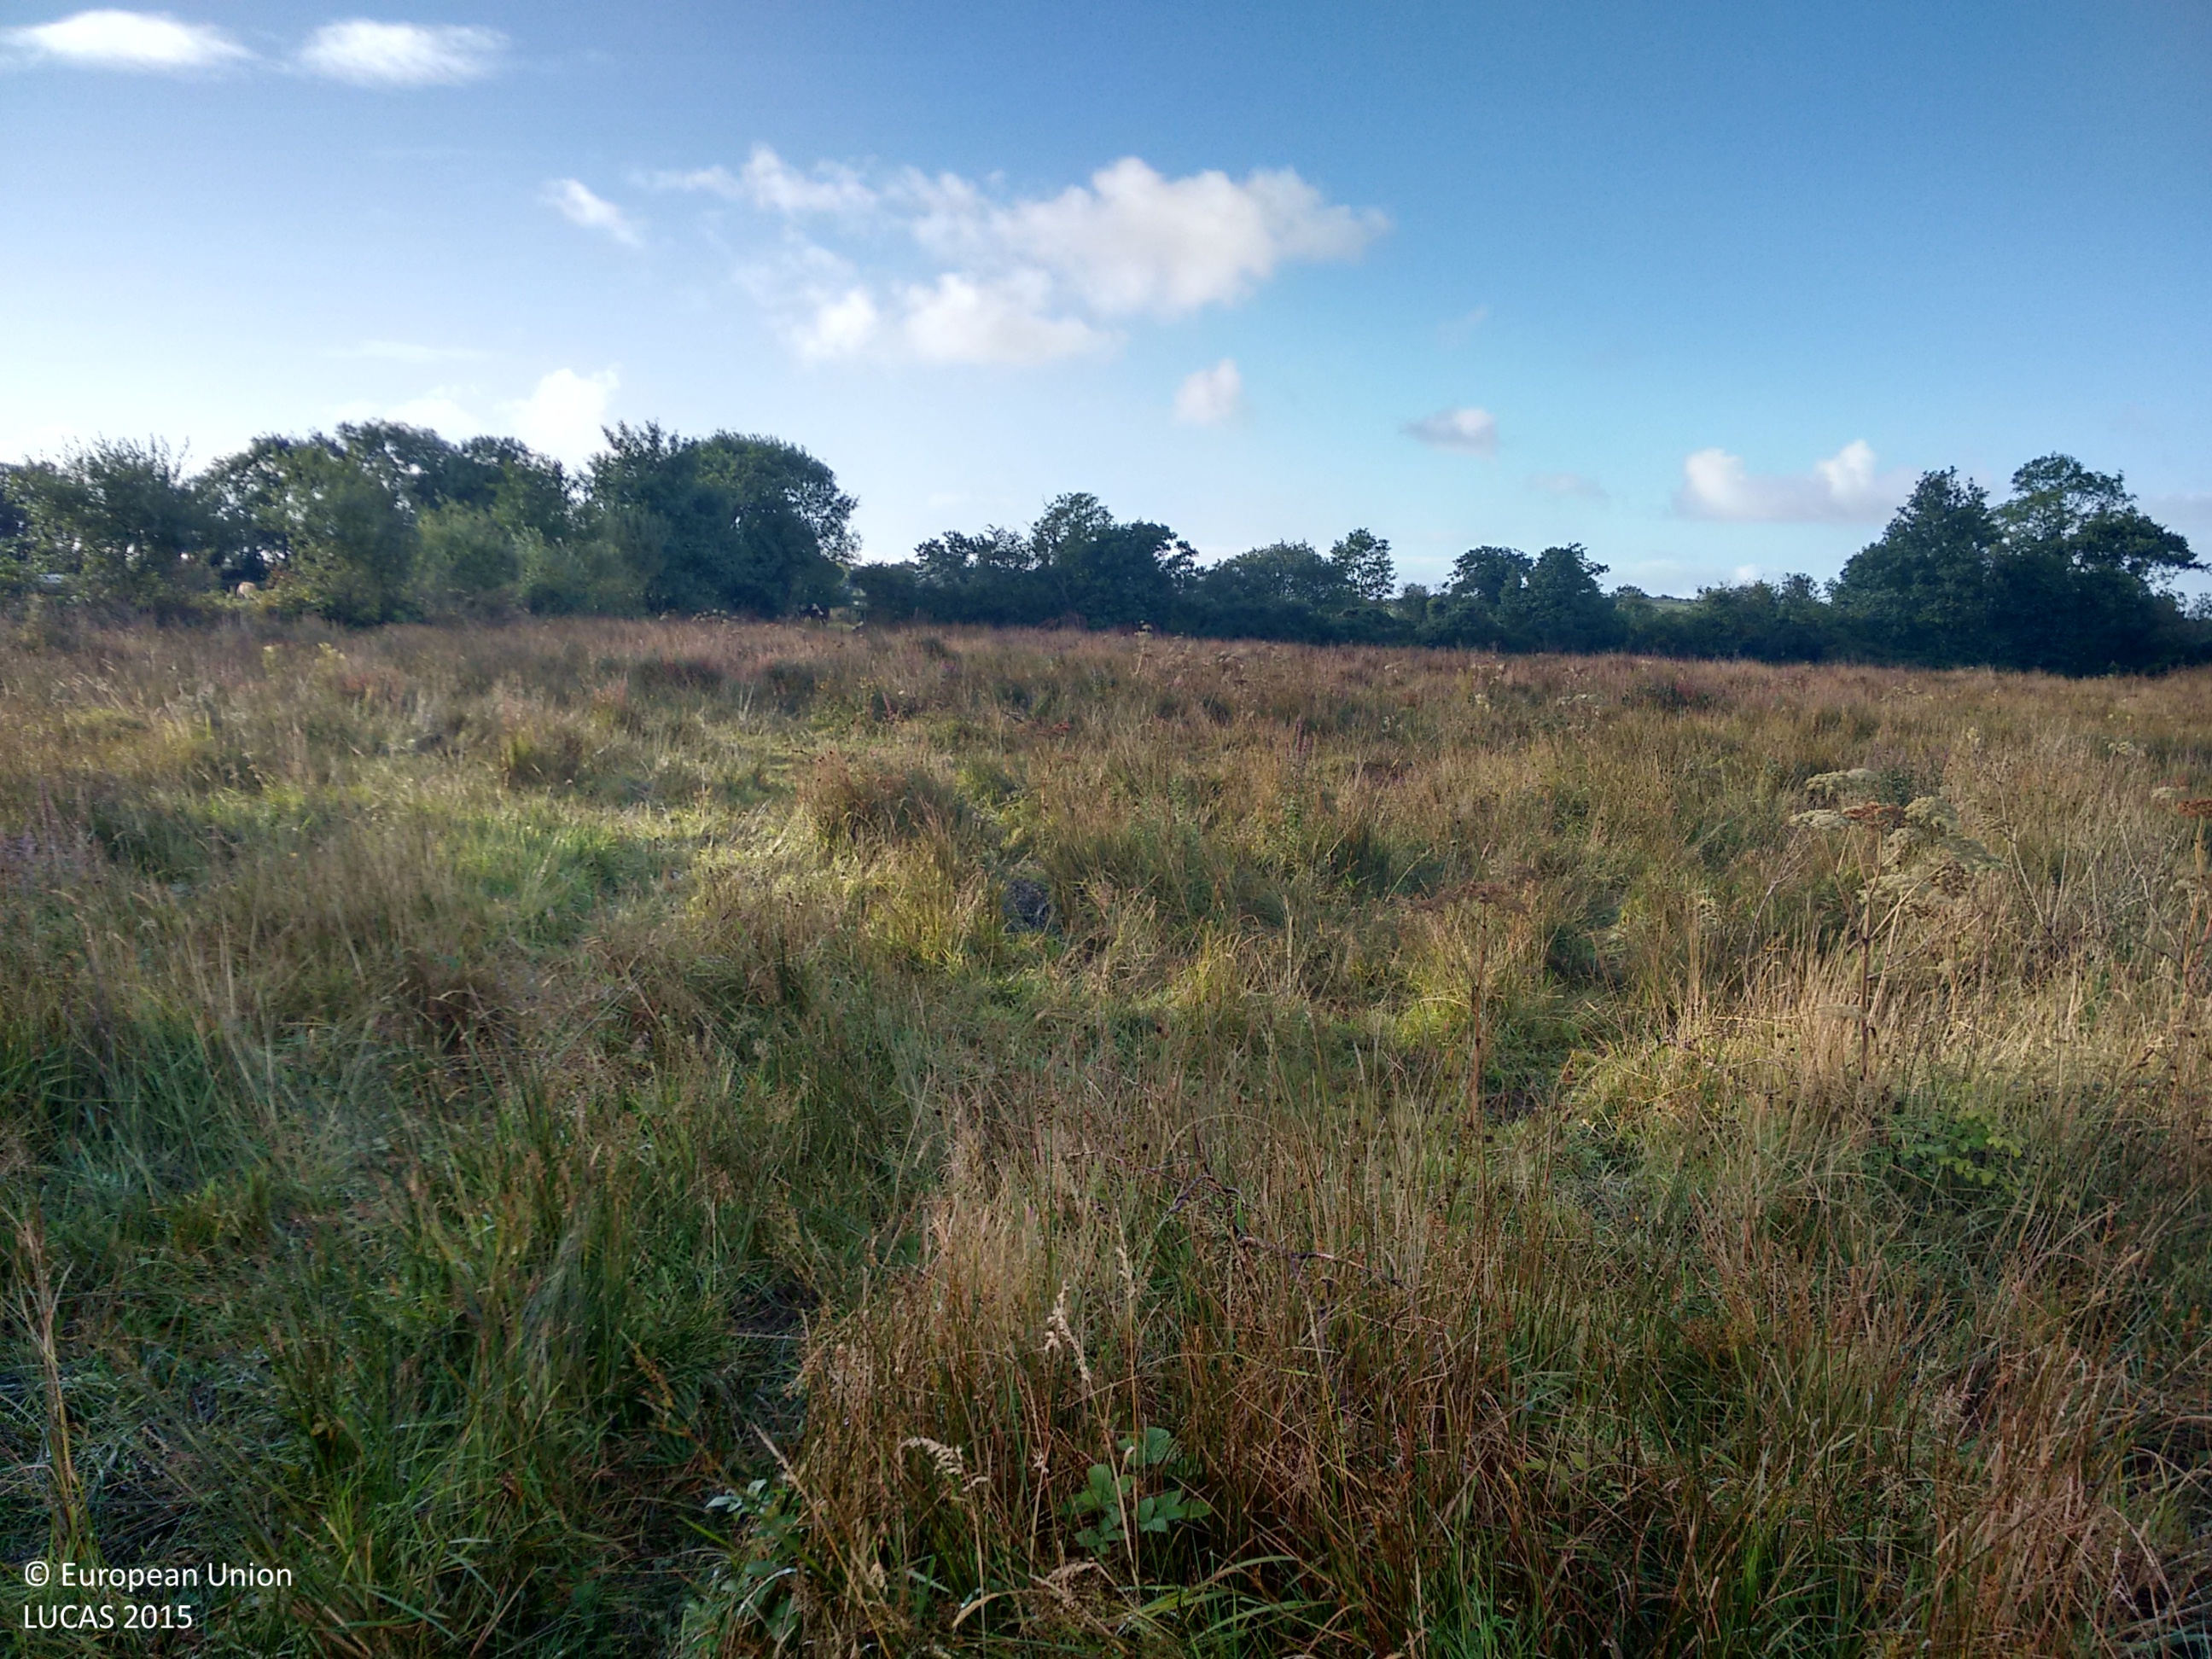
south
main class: Grassland
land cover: Spontaneously vegetated surfaces
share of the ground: > 75 %
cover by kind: herbaceous plants 100 %
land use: Agriculture (excluding fallow land and kitchen gardens)
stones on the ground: < 10 %
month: September
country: IE
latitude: 55.0254
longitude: -7.6315
